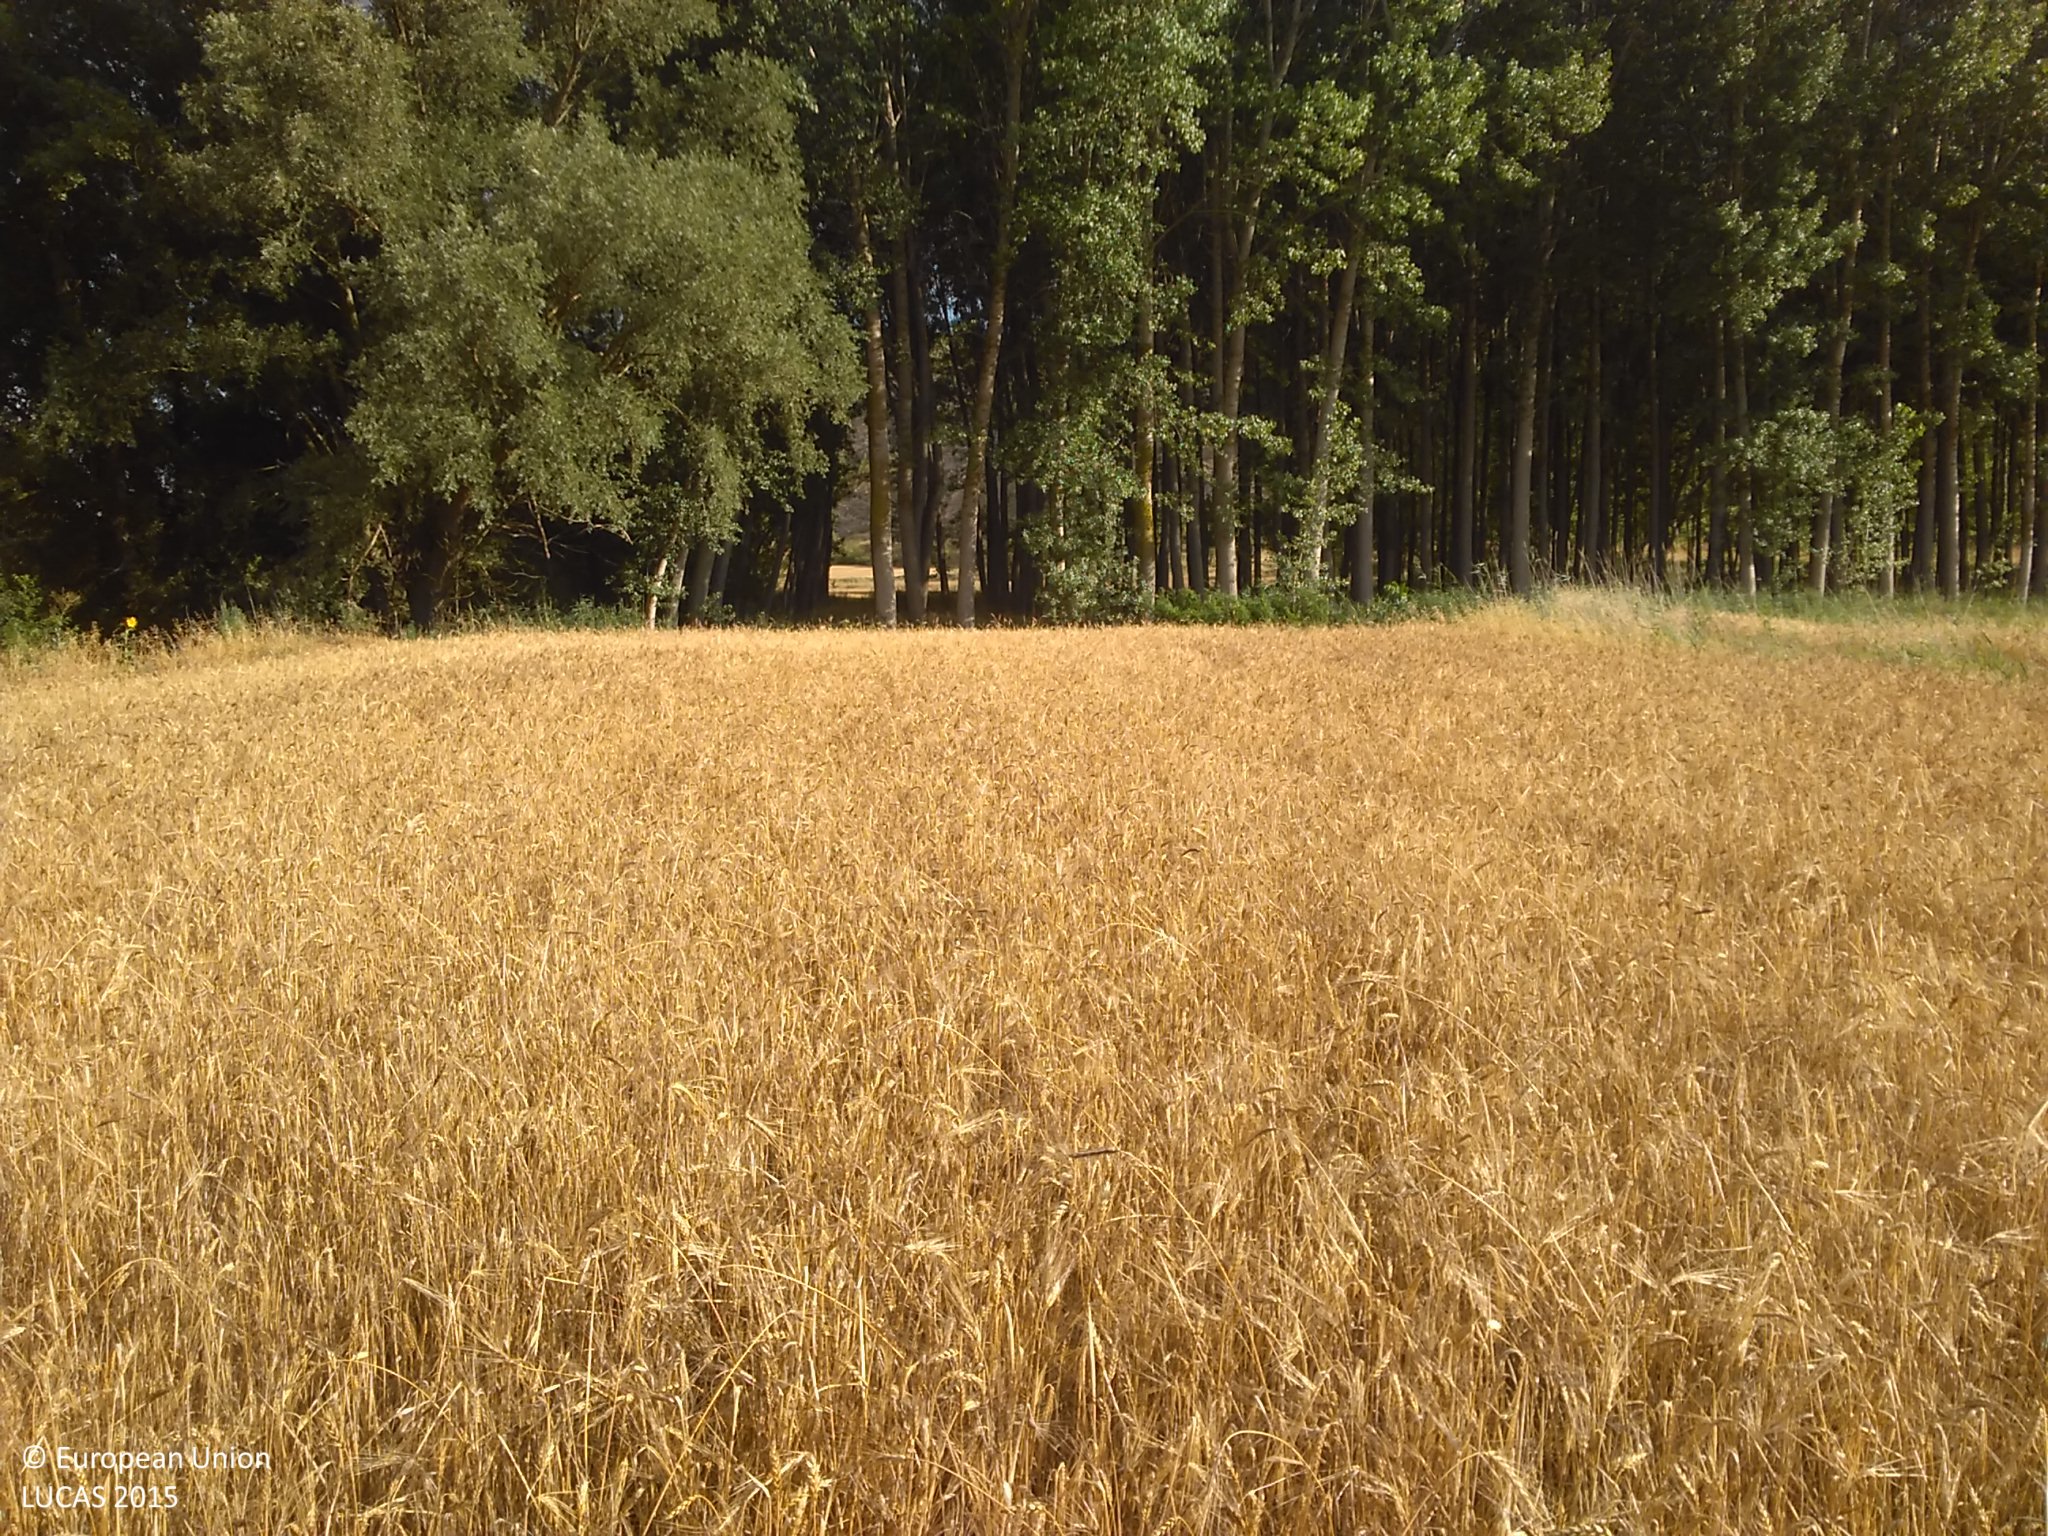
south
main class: Cropland
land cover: Common wheat
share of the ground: > 75 %
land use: Agriculture (excluding fallow land and kitchen gardens)
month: July
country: ES
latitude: 41.4083
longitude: -2.0039
